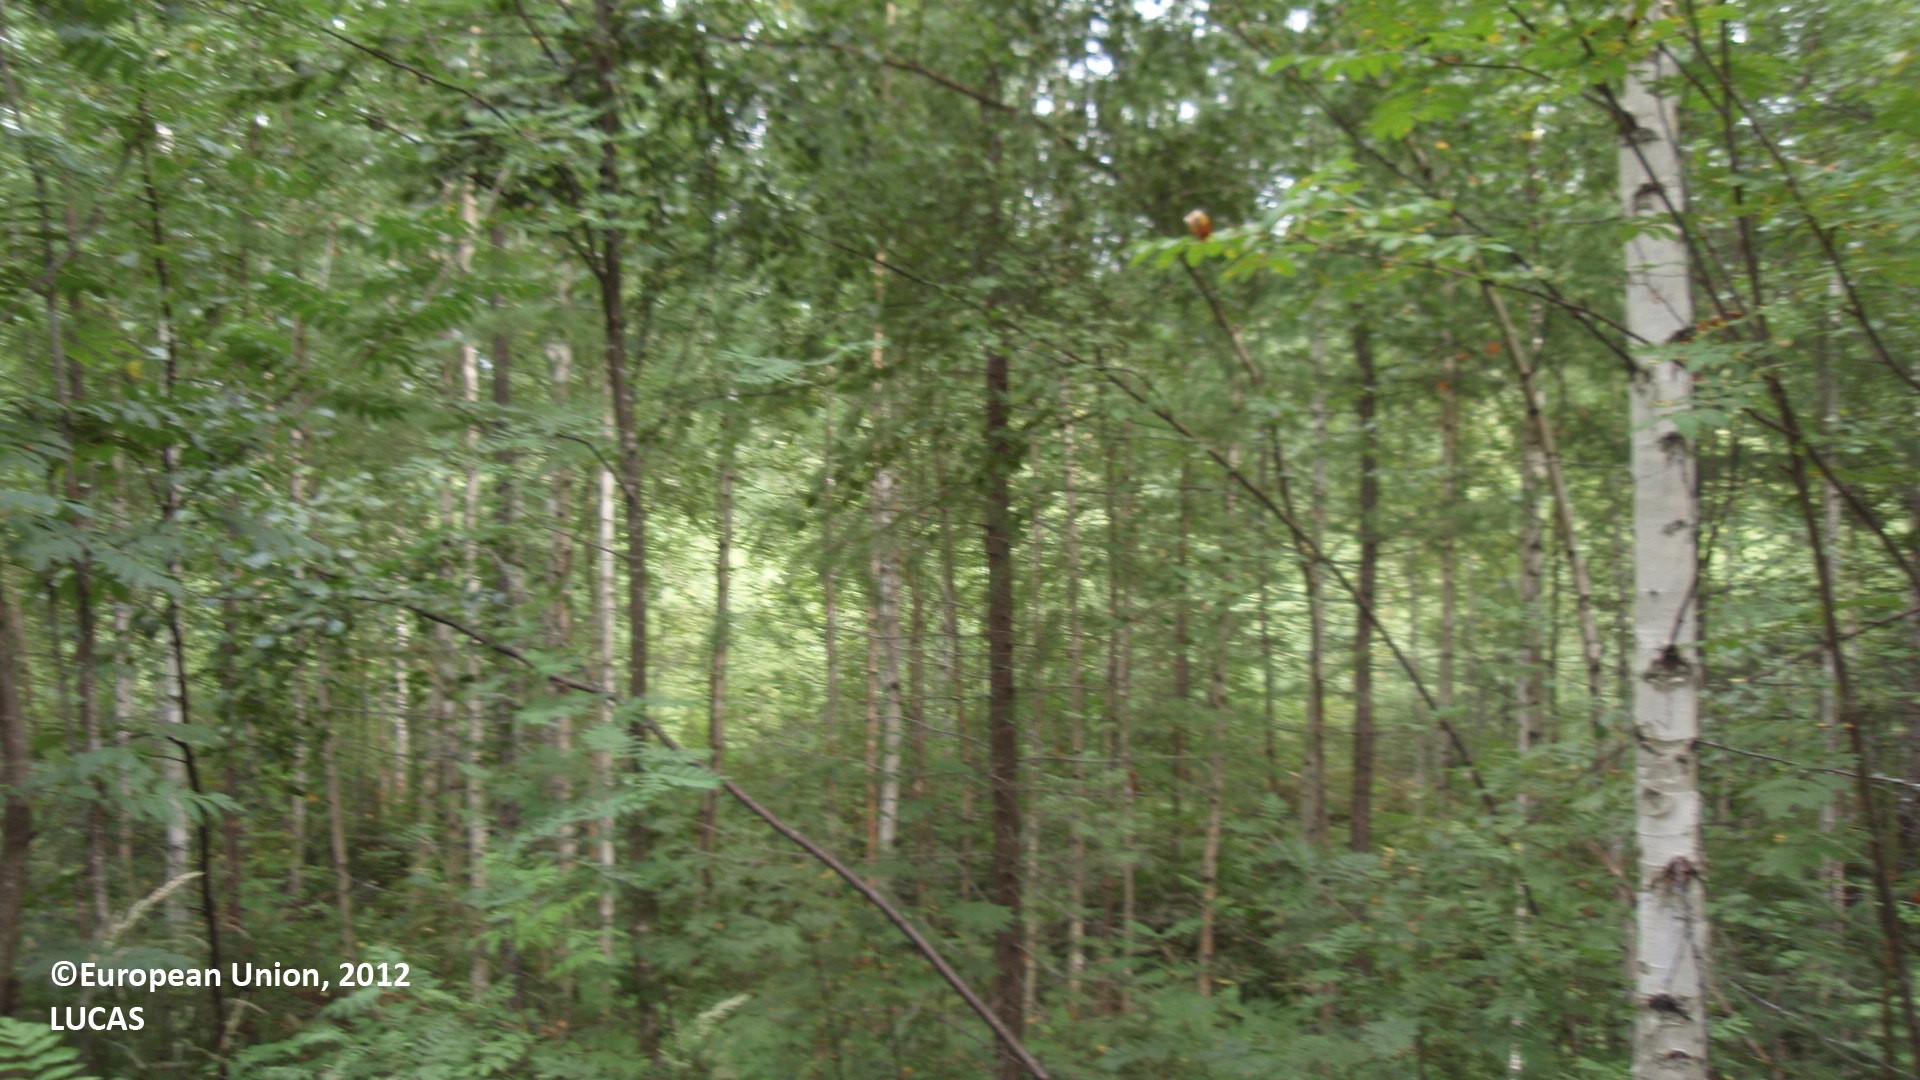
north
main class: Woodland
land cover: Broadleaved woodland
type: non-riverine alder, birch or aspen forest
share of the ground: 50 - 75 %
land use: Forestry
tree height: > 5 m
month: August
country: FI
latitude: 60.9200
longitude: 26.9312
